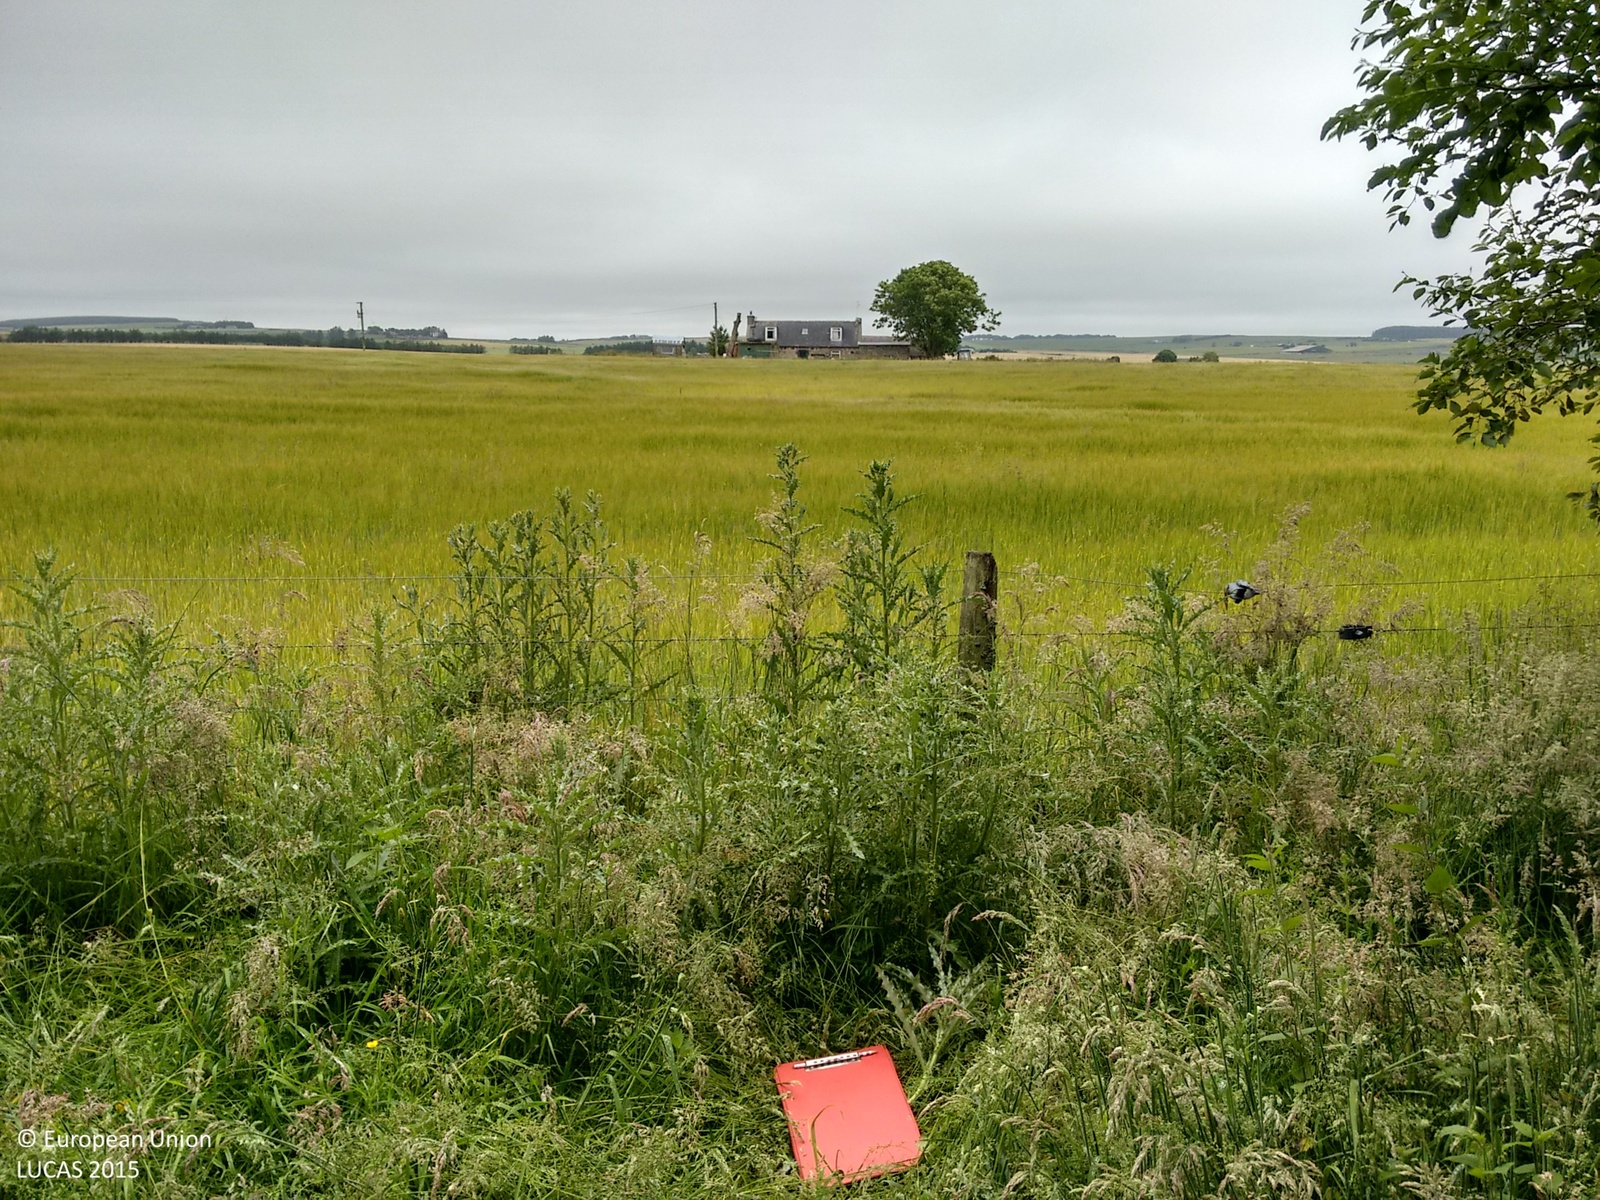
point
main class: Woodland
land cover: Broadleaved woodland
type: mesophytic deciduous forest
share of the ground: > 75 %
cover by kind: broadleaved forest trees 90 %, herbaceous plants 10 %
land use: Forestry
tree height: > 5 m
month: July
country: GB
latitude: 57.4258
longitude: -1.9857
